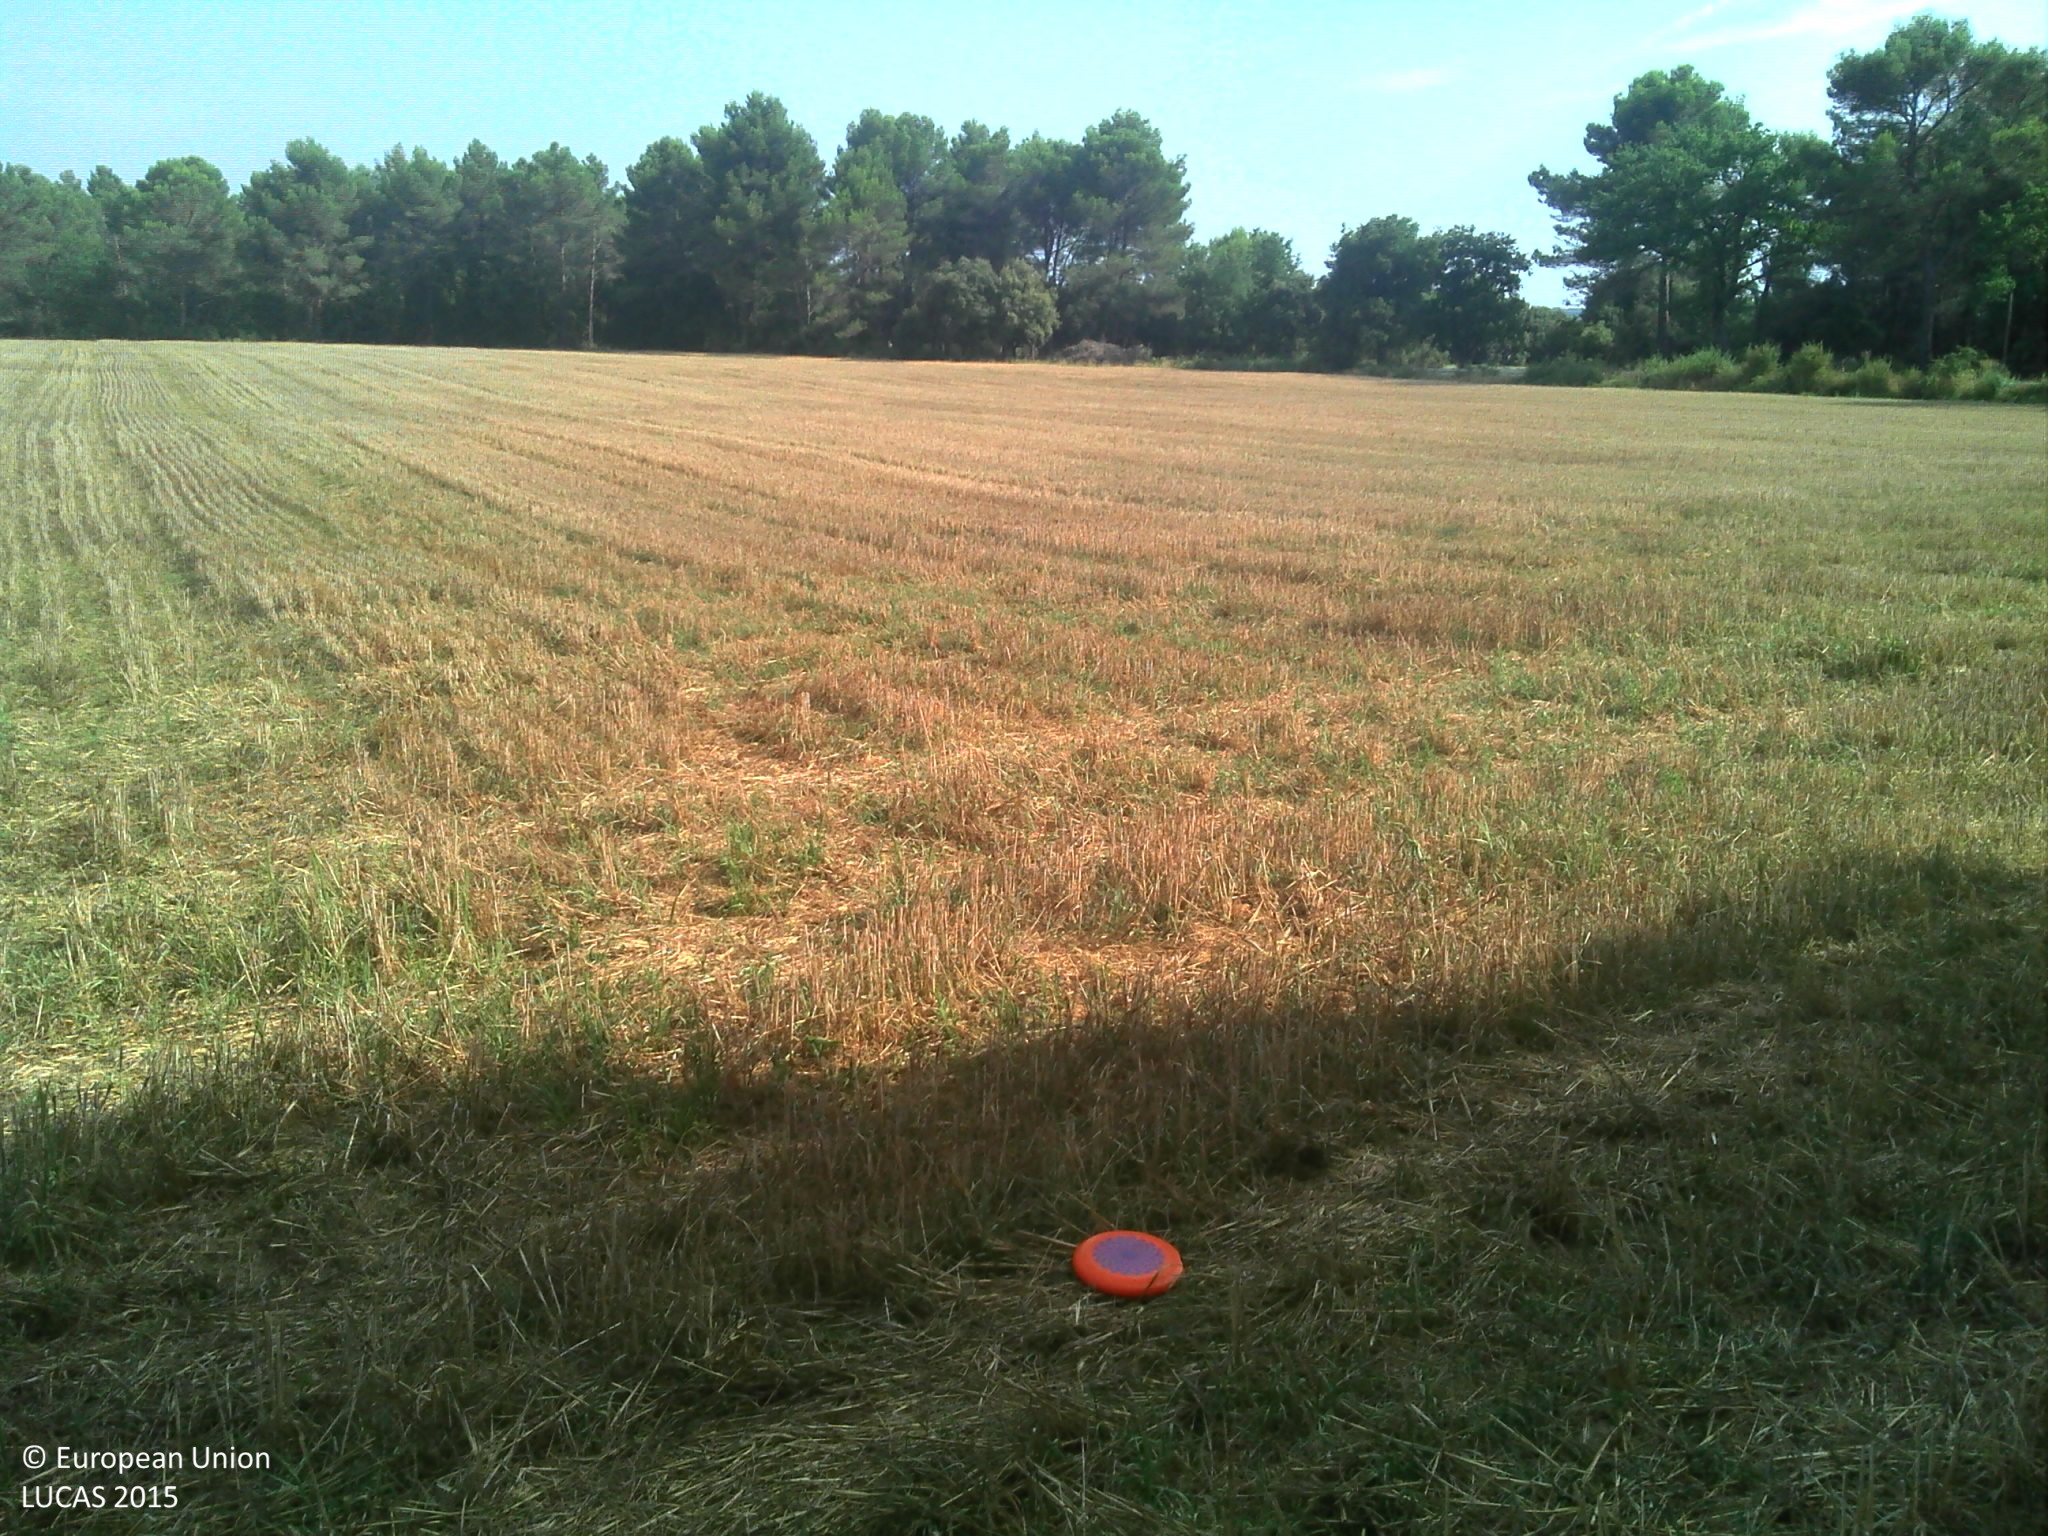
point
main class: Cropland
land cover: Durum wheat
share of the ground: > 75 %
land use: Agriculture (excluding fallow land and kitchen gardens)
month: August
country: FR
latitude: 43.6146
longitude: 5.3629
